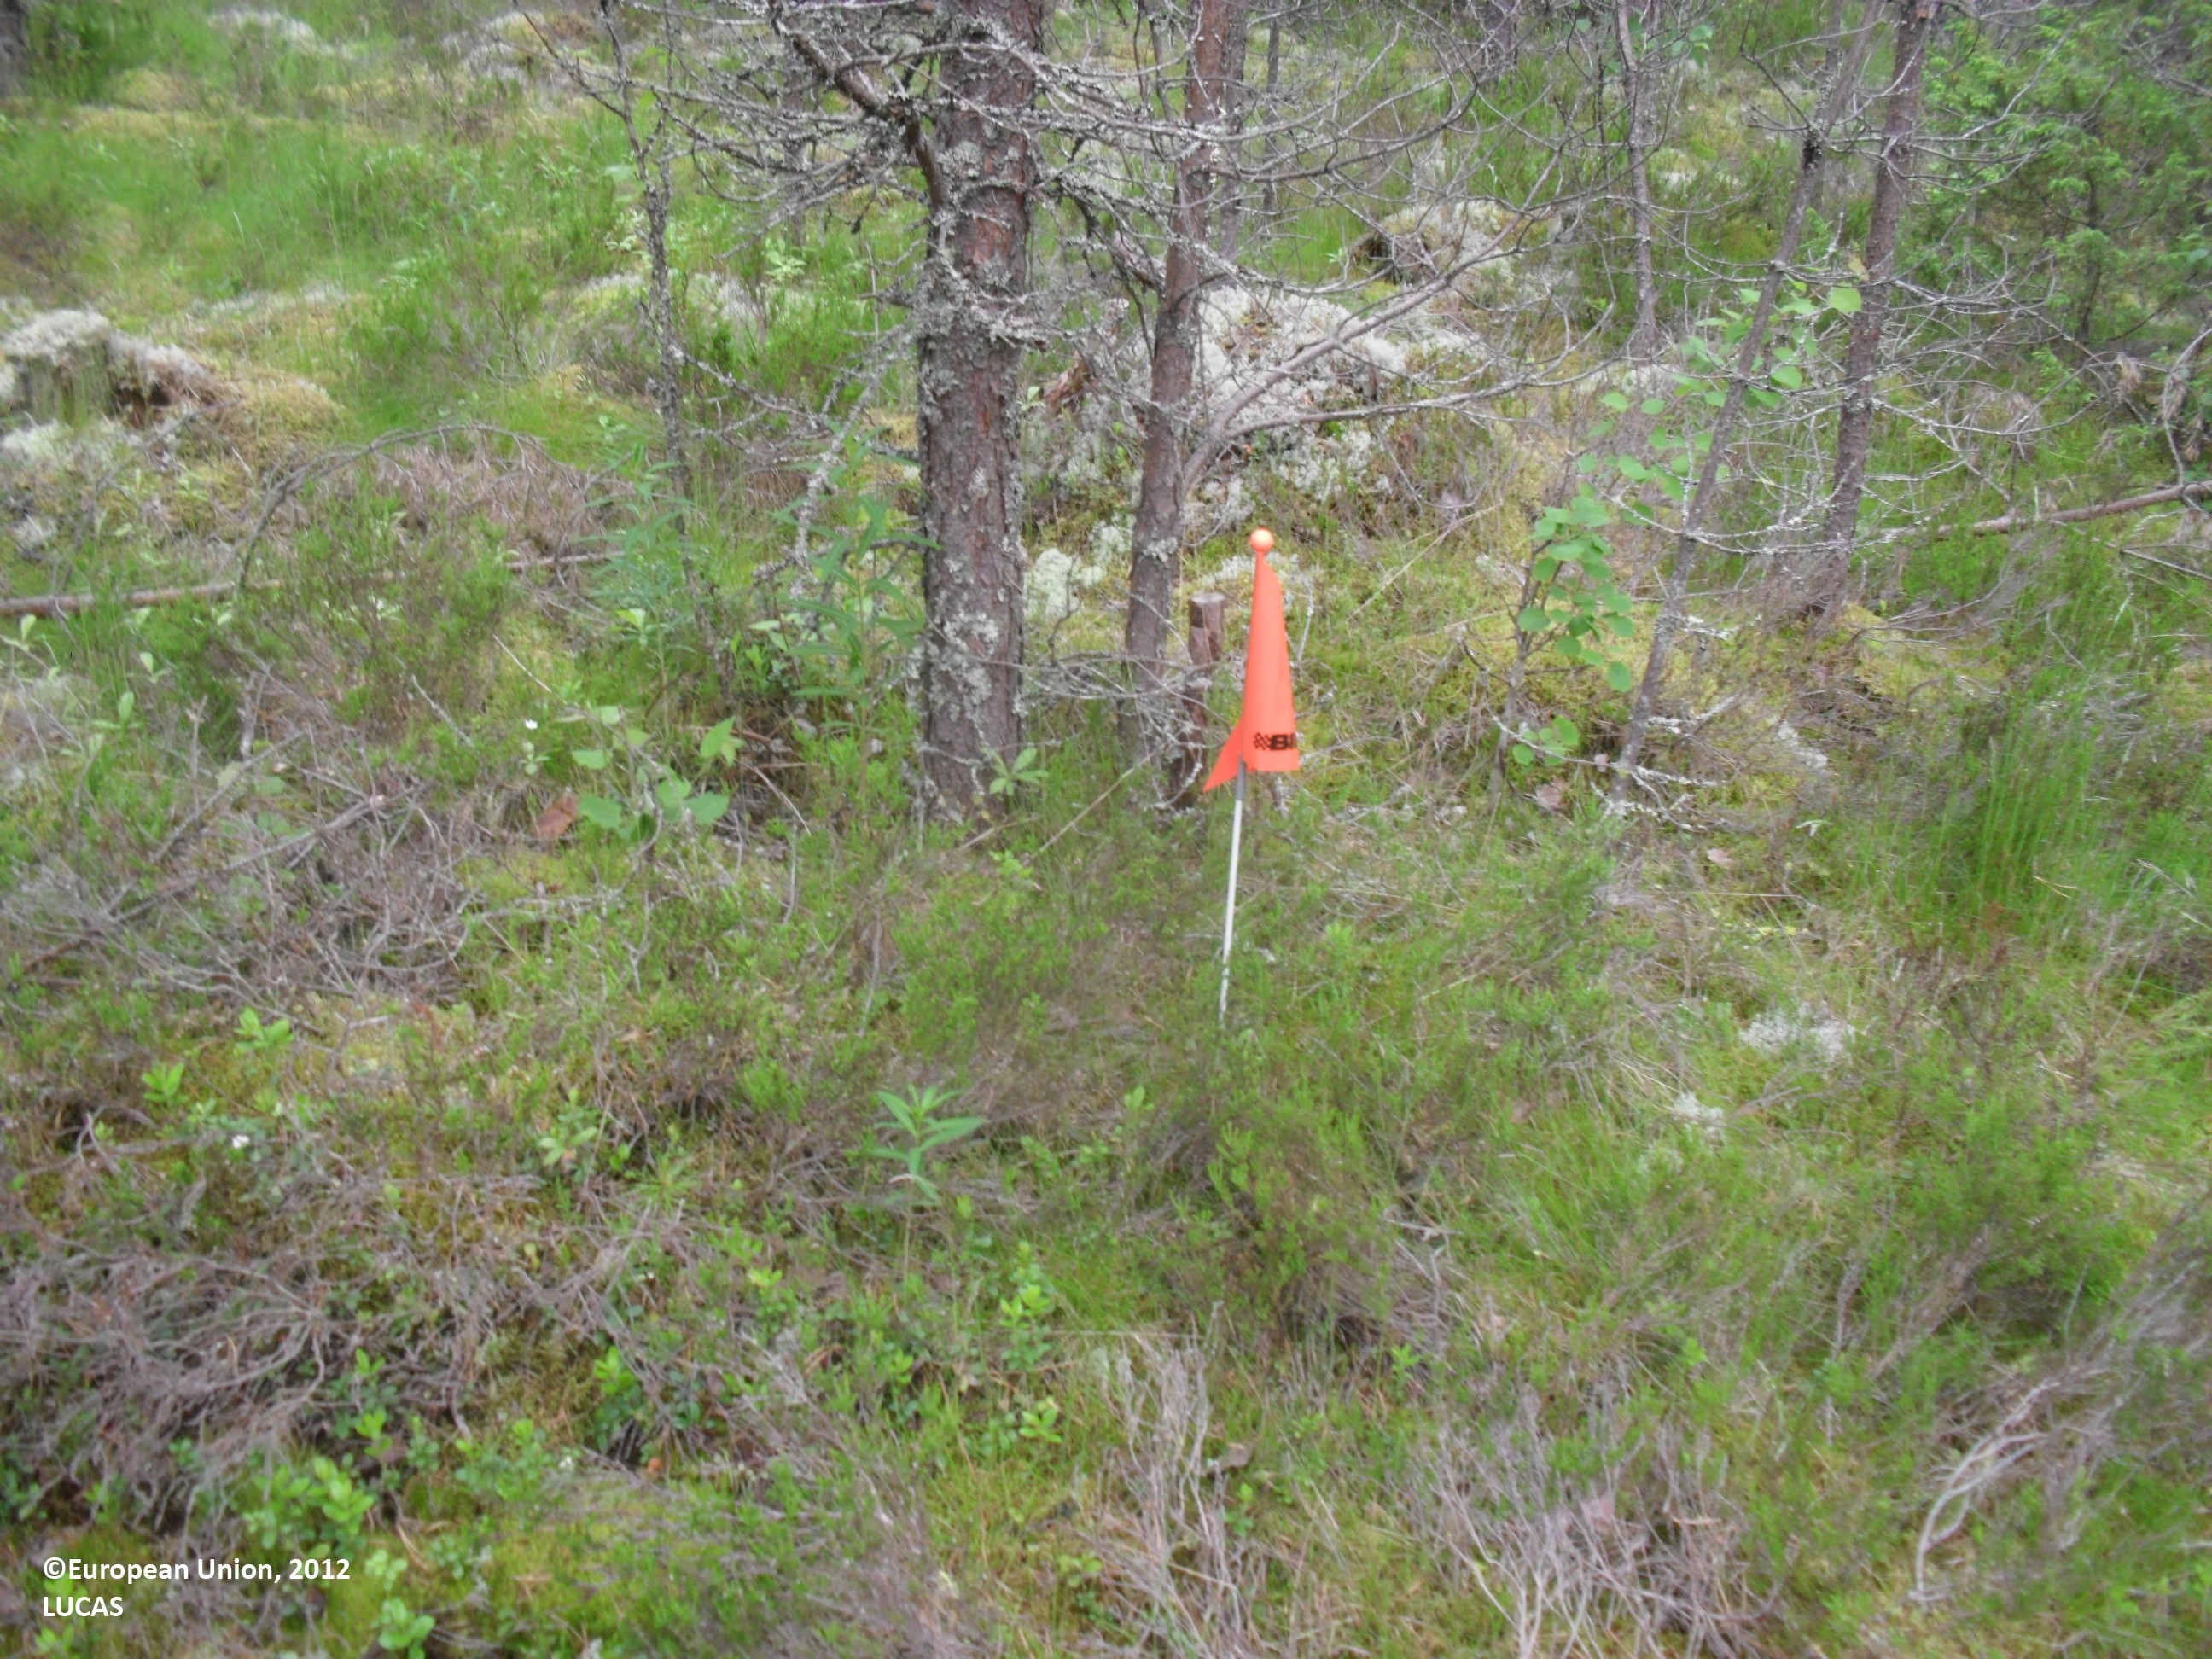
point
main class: Woodland
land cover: Pine dominated coniferous woodland
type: boreal forest
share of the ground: 50 - 75 %
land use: Forestry
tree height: > 5 m
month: June
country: FI
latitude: 62.9099
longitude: 23.5913
